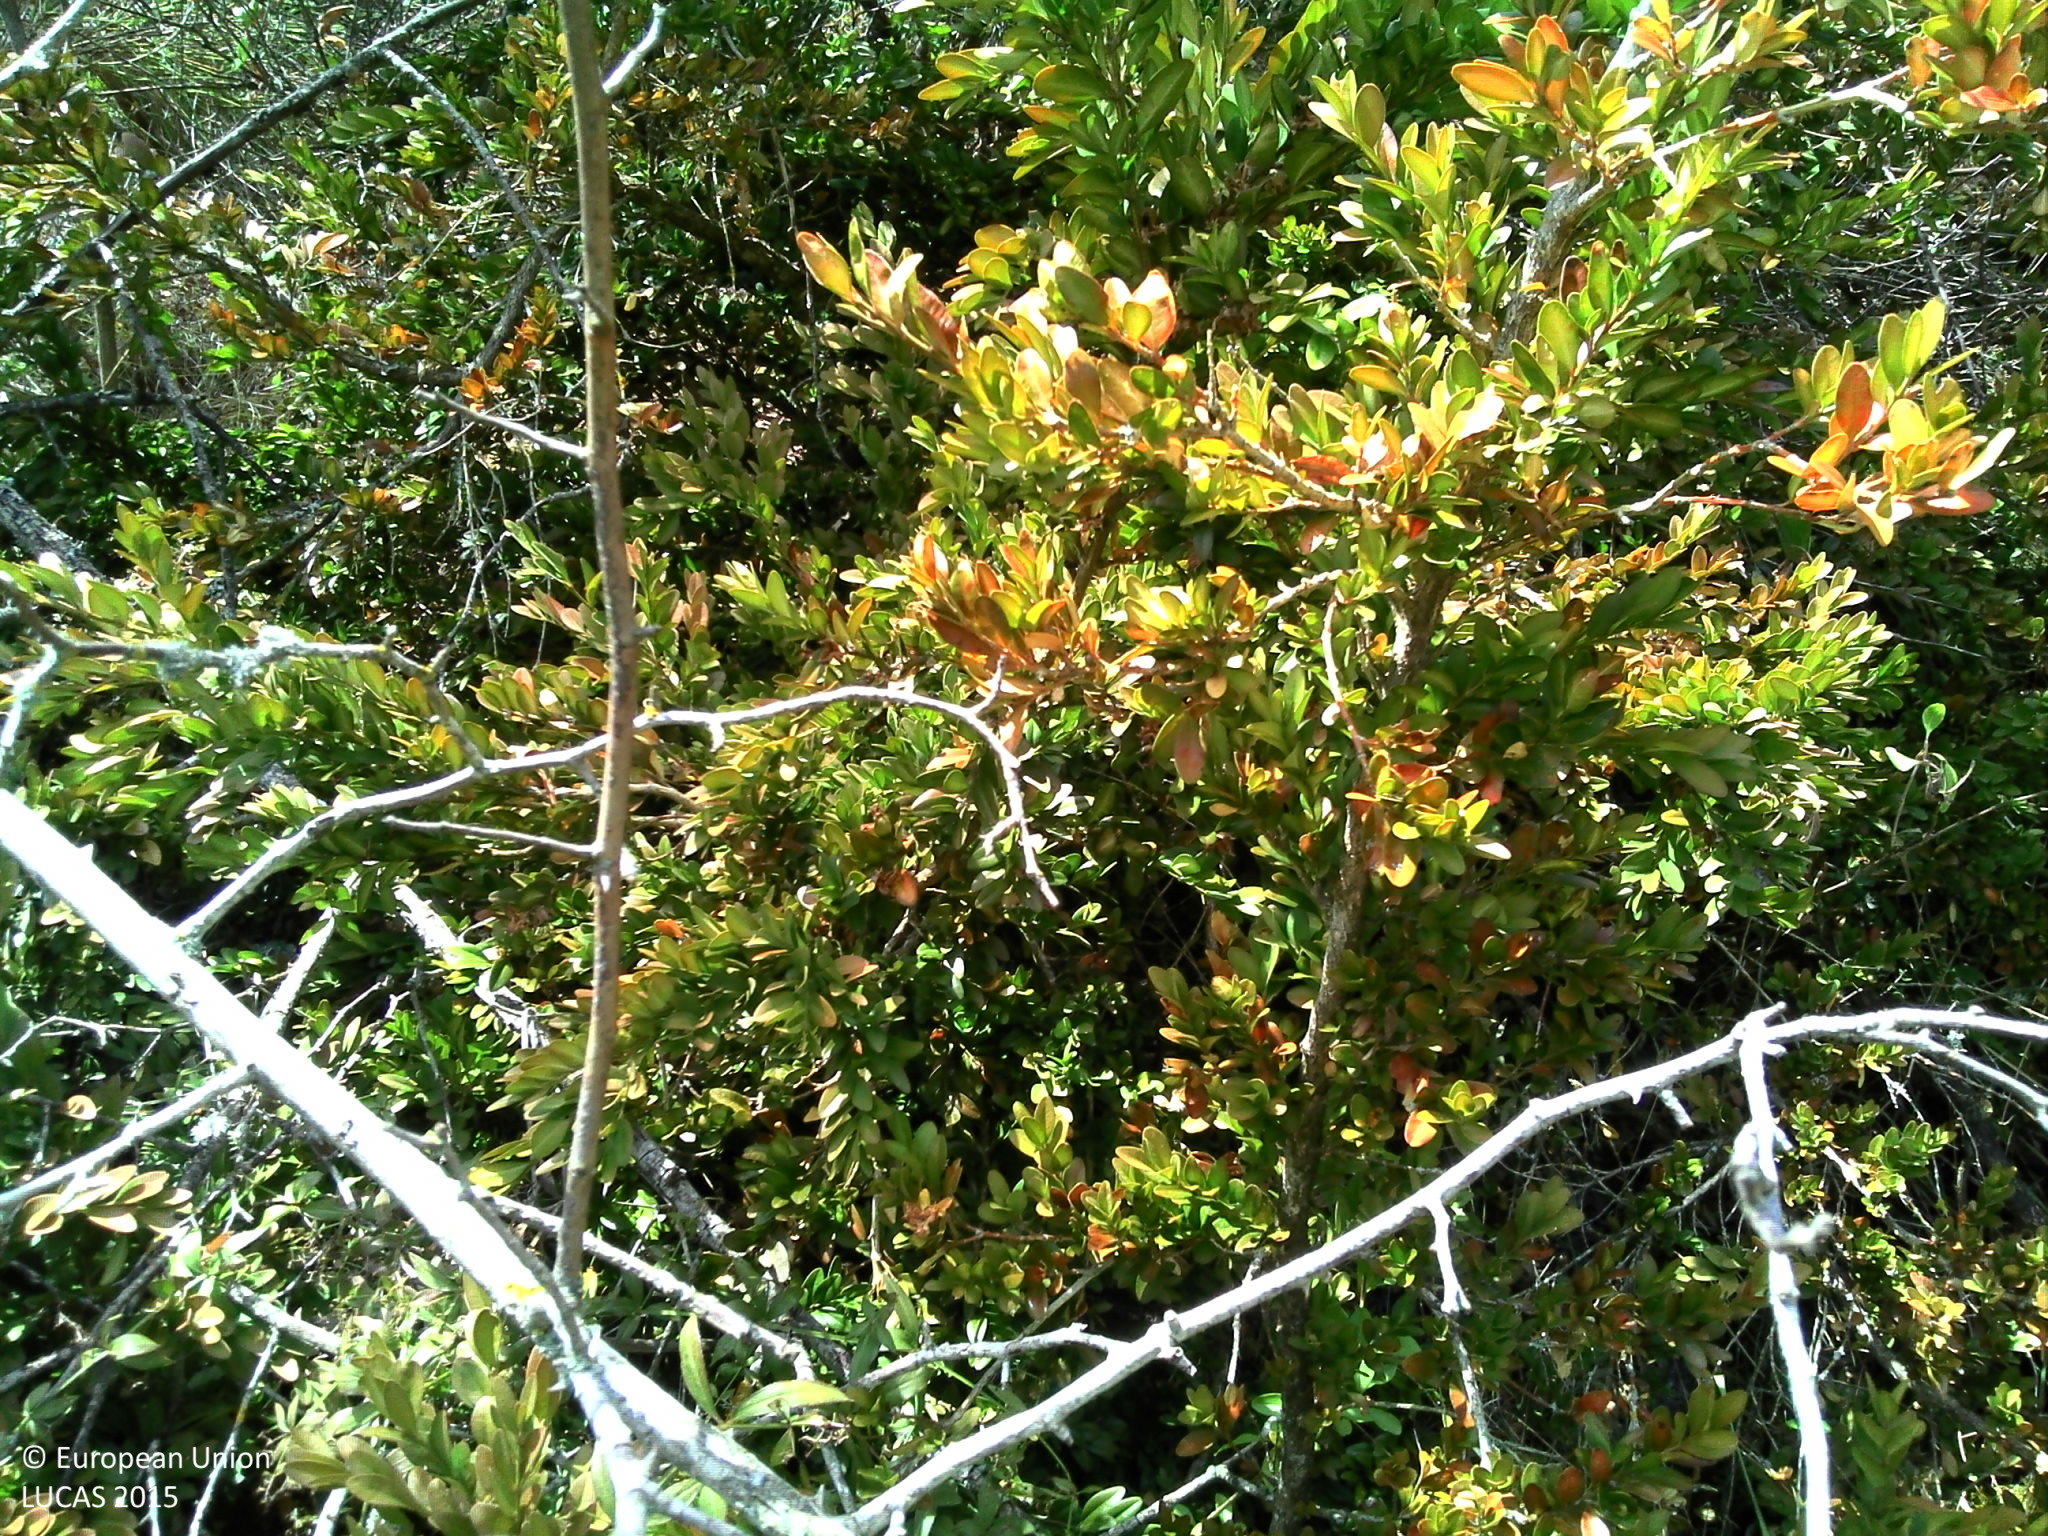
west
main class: Shrubland
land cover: Shrubland without tree cover
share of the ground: > 75 %
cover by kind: shrubs 80 %, unconsolidated bare surface 20 %
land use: Semi-natural and natural areas not in use
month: August
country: FR
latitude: 43.8365
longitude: 3.1794
